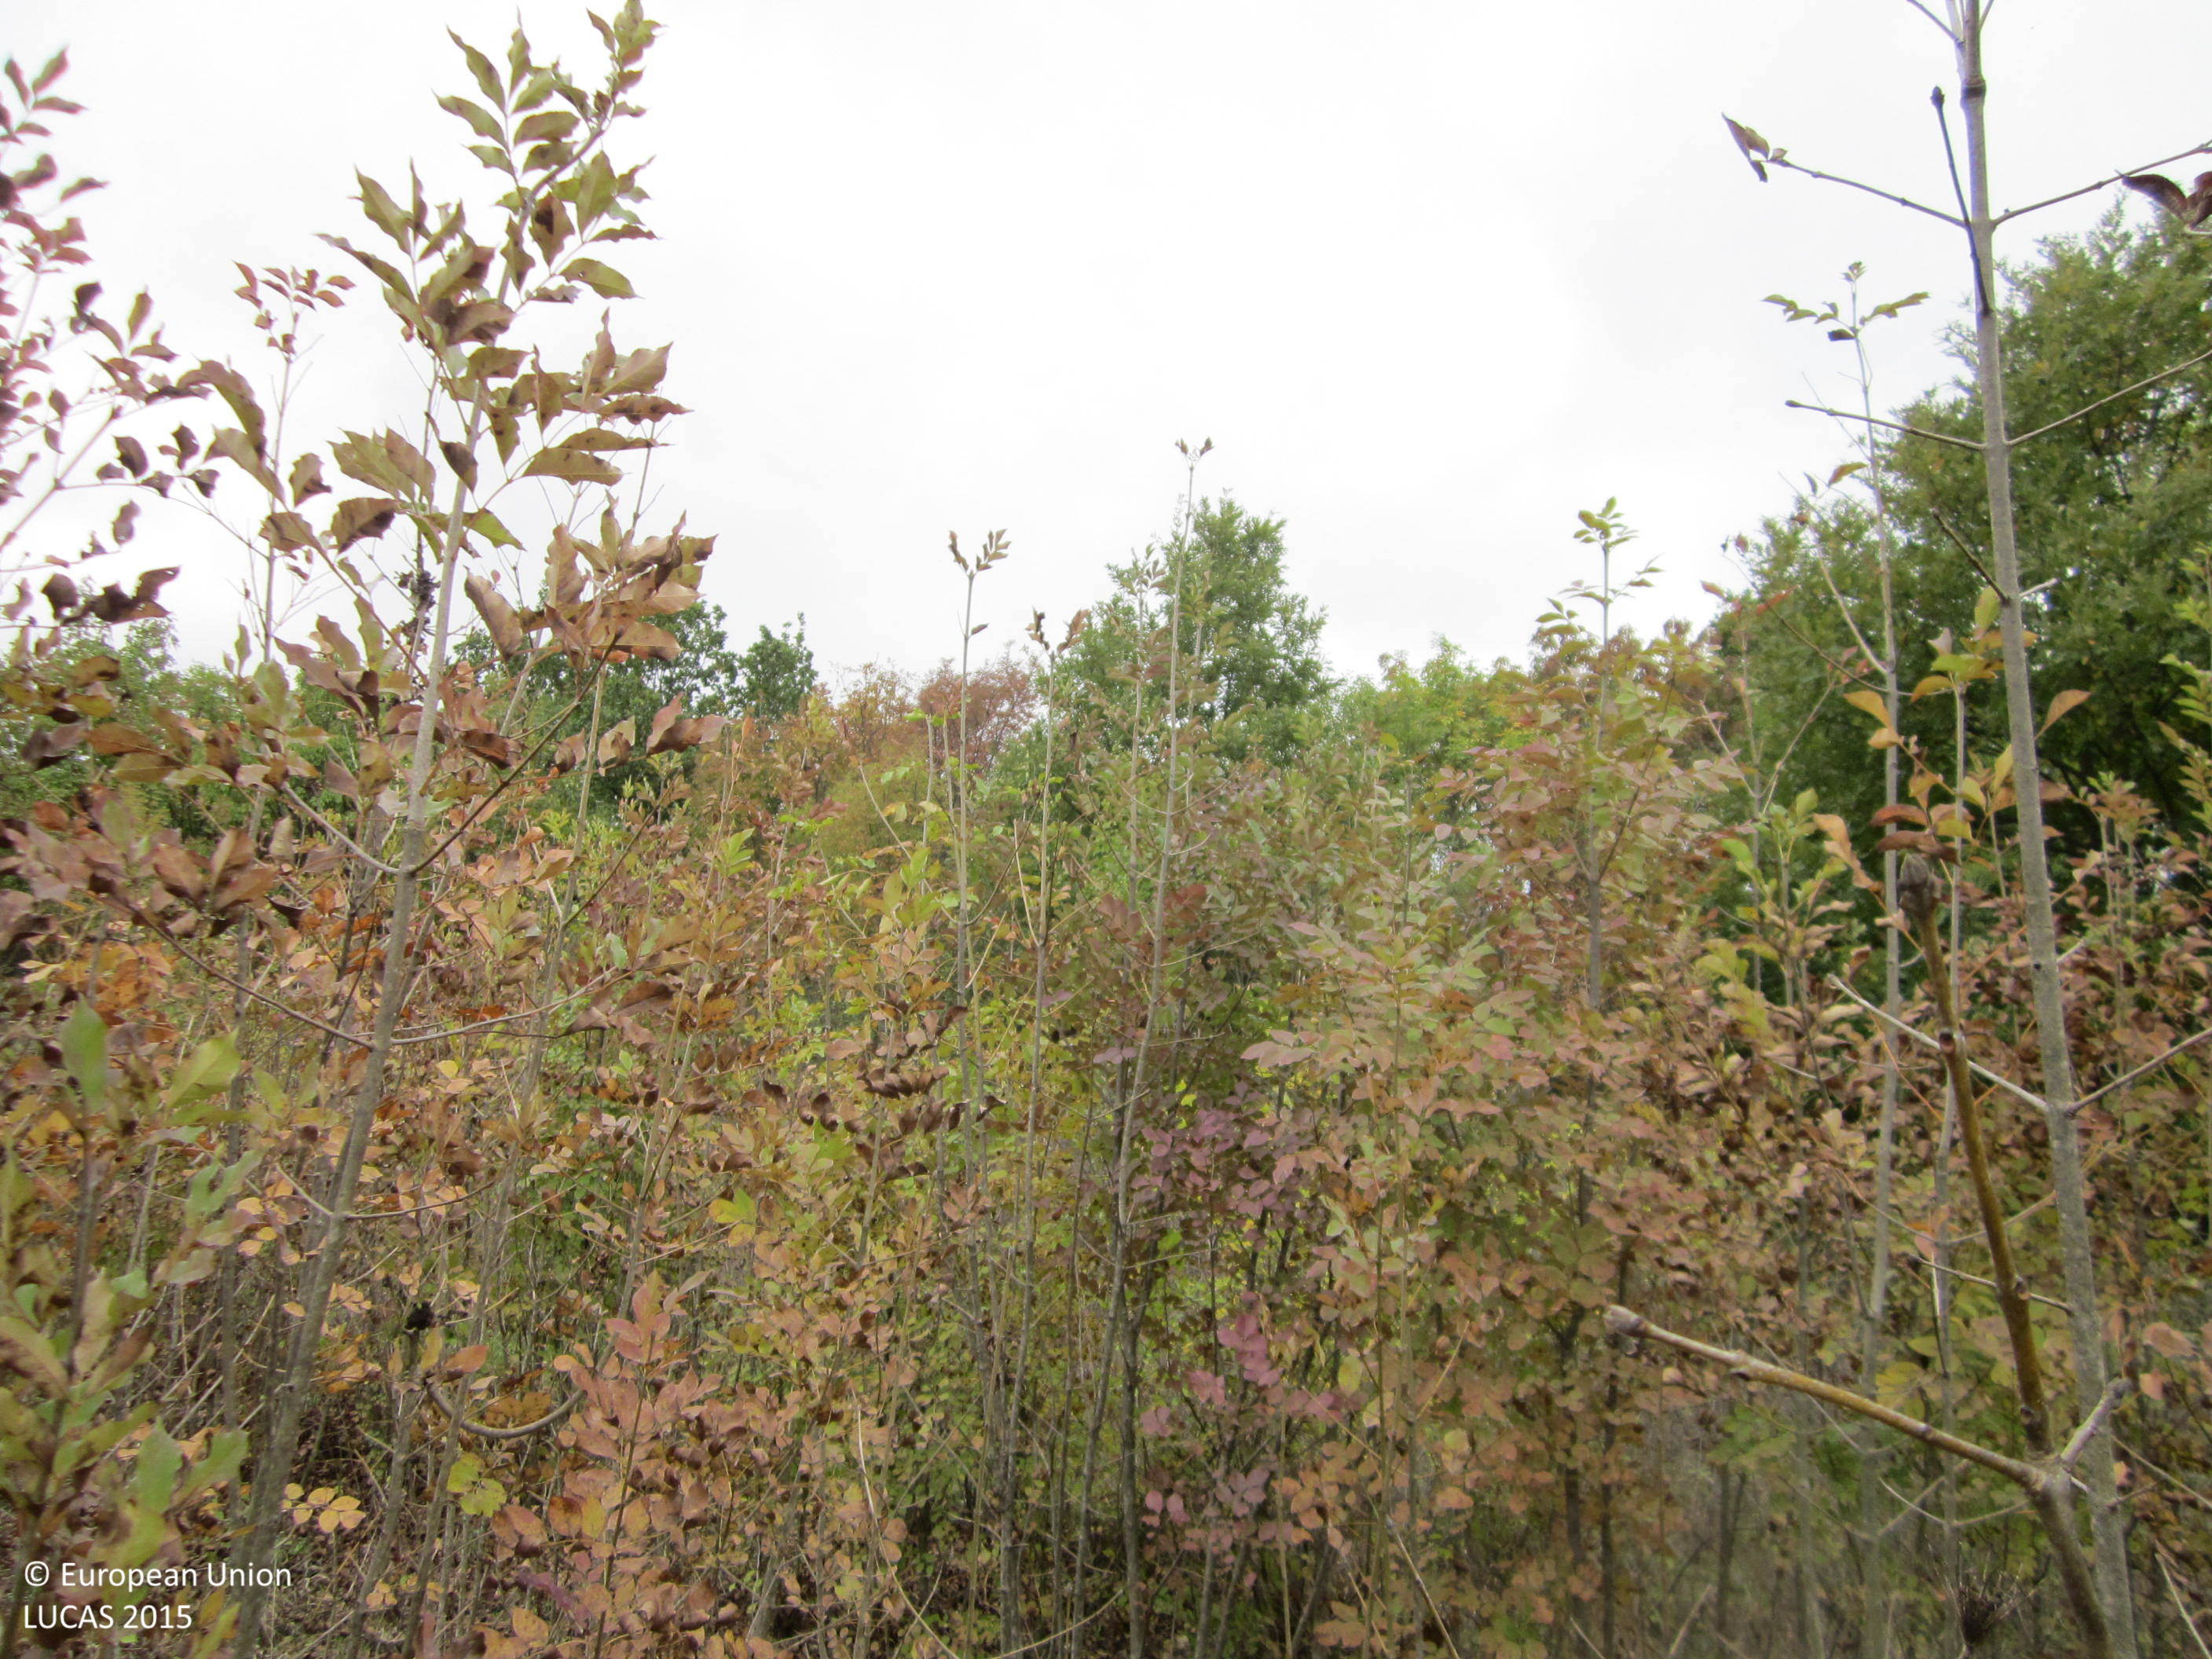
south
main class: Woodland
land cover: Broadleaved woodland
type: mesophytic deciduous forest
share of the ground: 50 - 75 %
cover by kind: broadleaved forest trees 70 %, shrubs 15 %, herbaceous plants 15 %
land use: Forestry
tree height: < 5 m
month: October
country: BG
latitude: 42.3074
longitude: 27.2252
